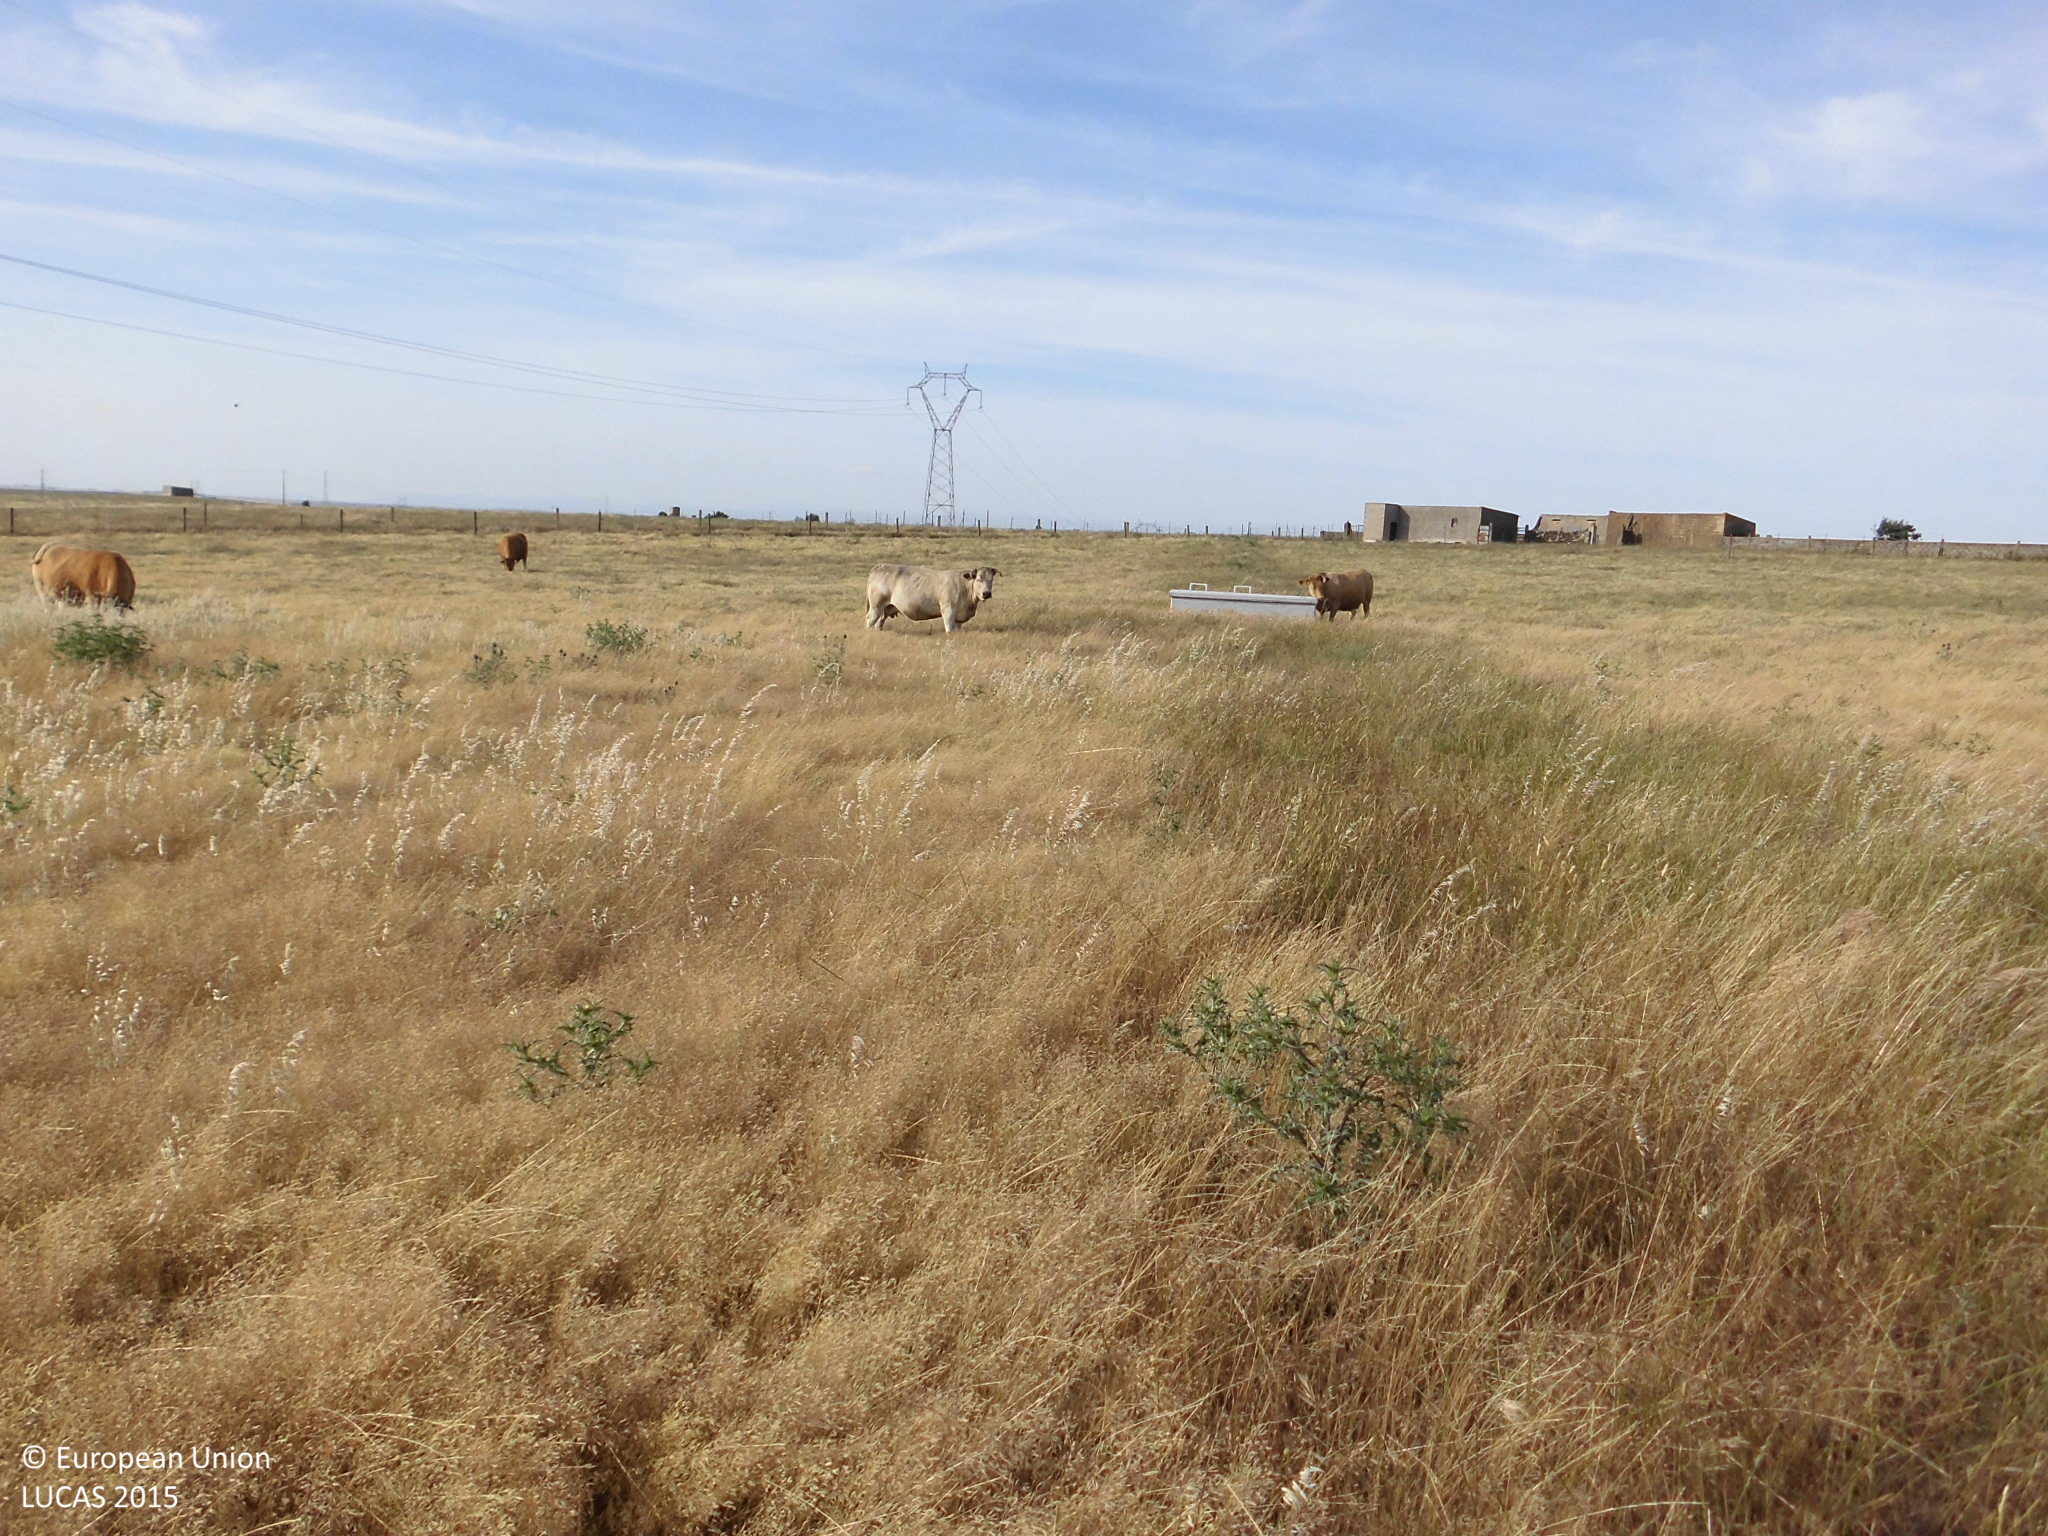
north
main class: Grassland
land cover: Grassland without tree/shrub cover
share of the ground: > 75 %
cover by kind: herbaceous plants 100 %
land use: Agriculture (excluding fallow land and kitchen gardens)
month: May
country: ES
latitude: 39.4154
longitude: -5.9360
